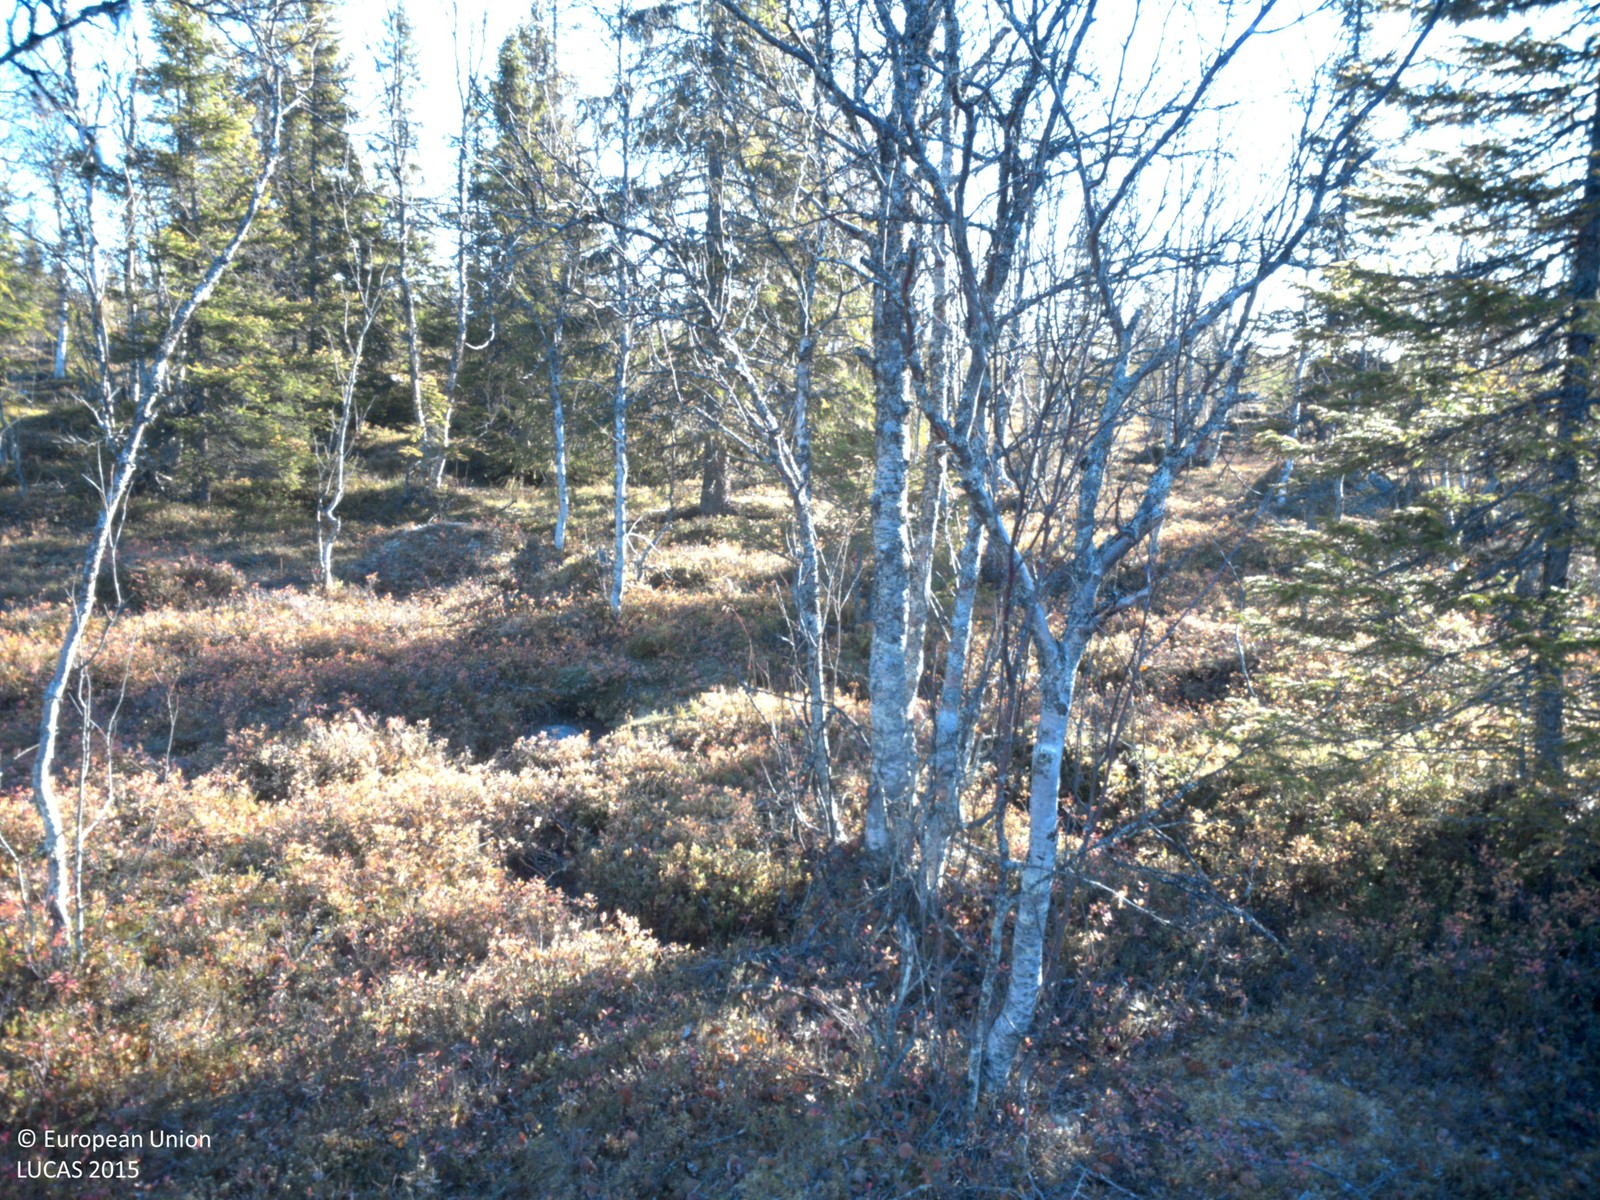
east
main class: Woodland
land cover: Spruce dominated mixed woodland
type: boreal forest
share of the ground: 25 - 50 %
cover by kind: shrubs 35 %, herbaceous plants 30 %, coniferous forest trees 15 %, broadleaved forest trees 15 %, lichens and mosses 5 %
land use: Forestry
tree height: < 5 m
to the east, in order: Spruce dominated mixed woodland; Broadleaved woodland; Spruce dominated mixed woodland
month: October
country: SE
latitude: 64.5917
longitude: 17.7162
